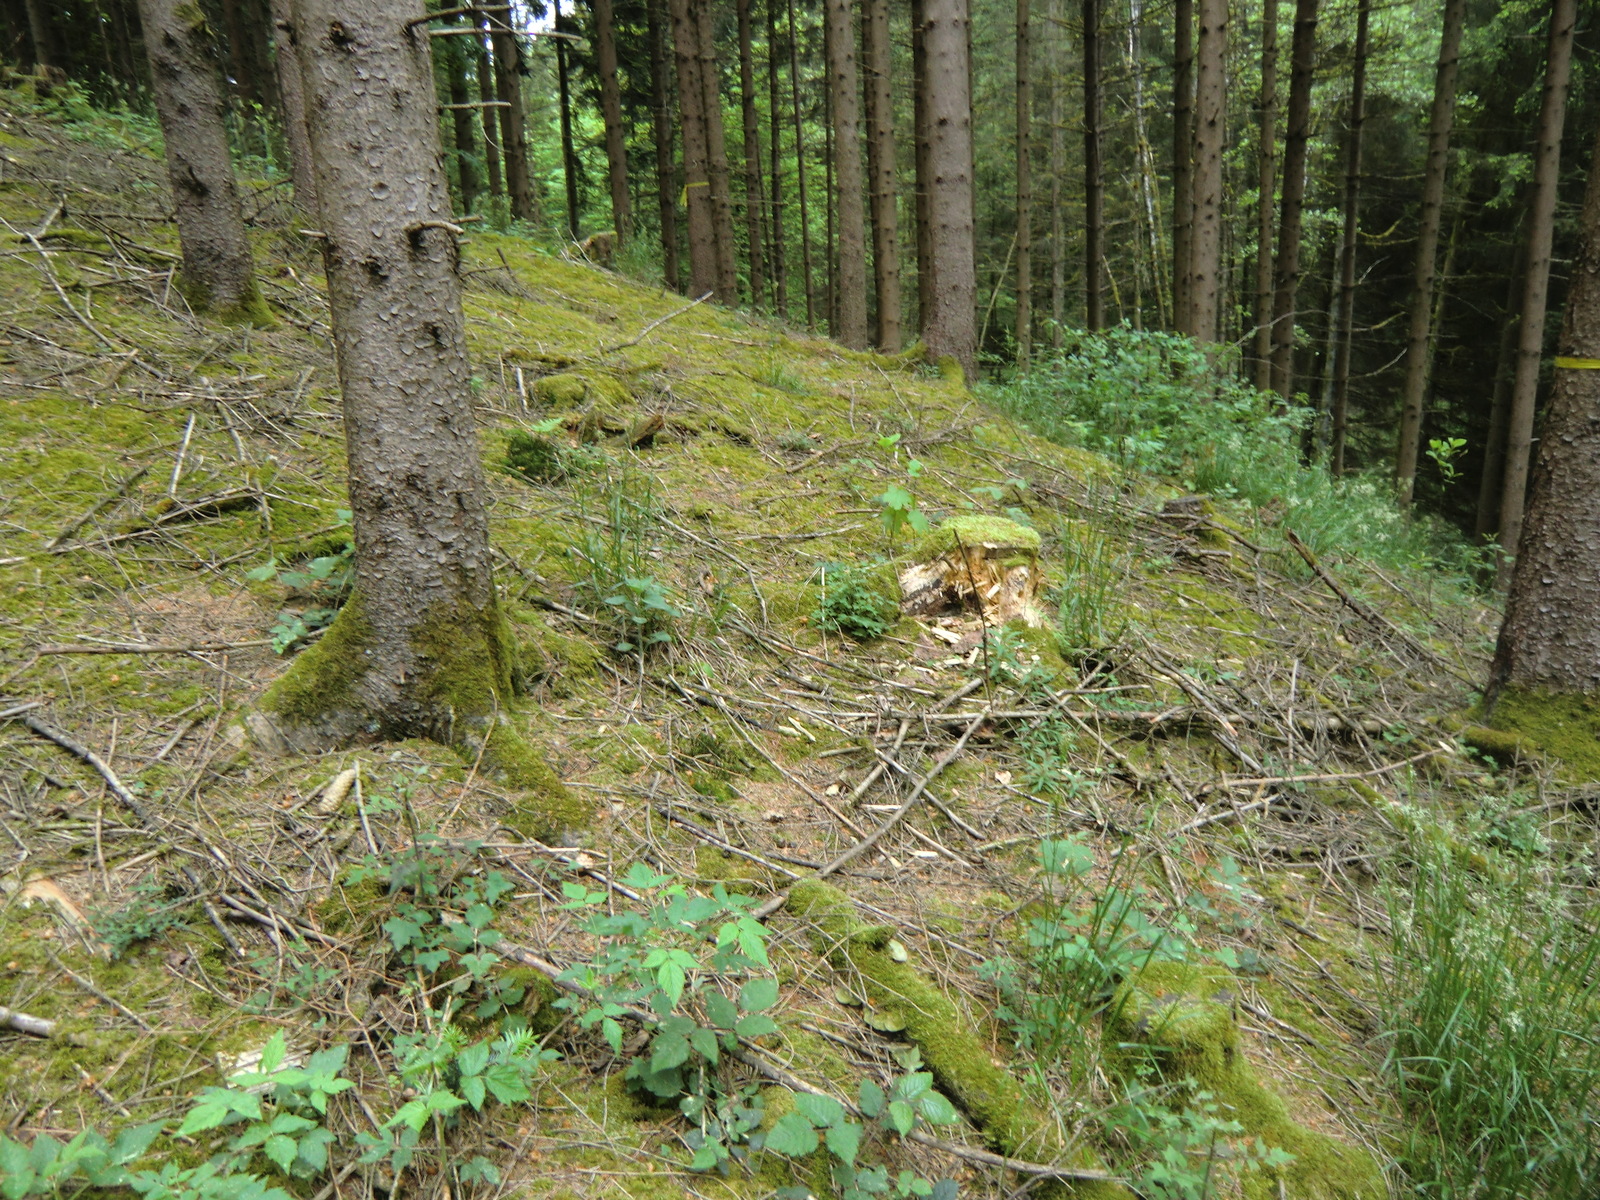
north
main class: Woodland
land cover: Spruce dominated coniferous woodland
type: hemiboreal forest and nemoral coniferous forest and mixed broadleaved-coniferous forest
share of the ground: > 75 %
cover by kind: coniferous forest trees 85 %, lichens and mosses 10 %, consolidated bare surface 5 %
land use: Forestry
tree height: > 5 m
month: May
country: AT
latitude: 48.2078
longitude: 14.8318
